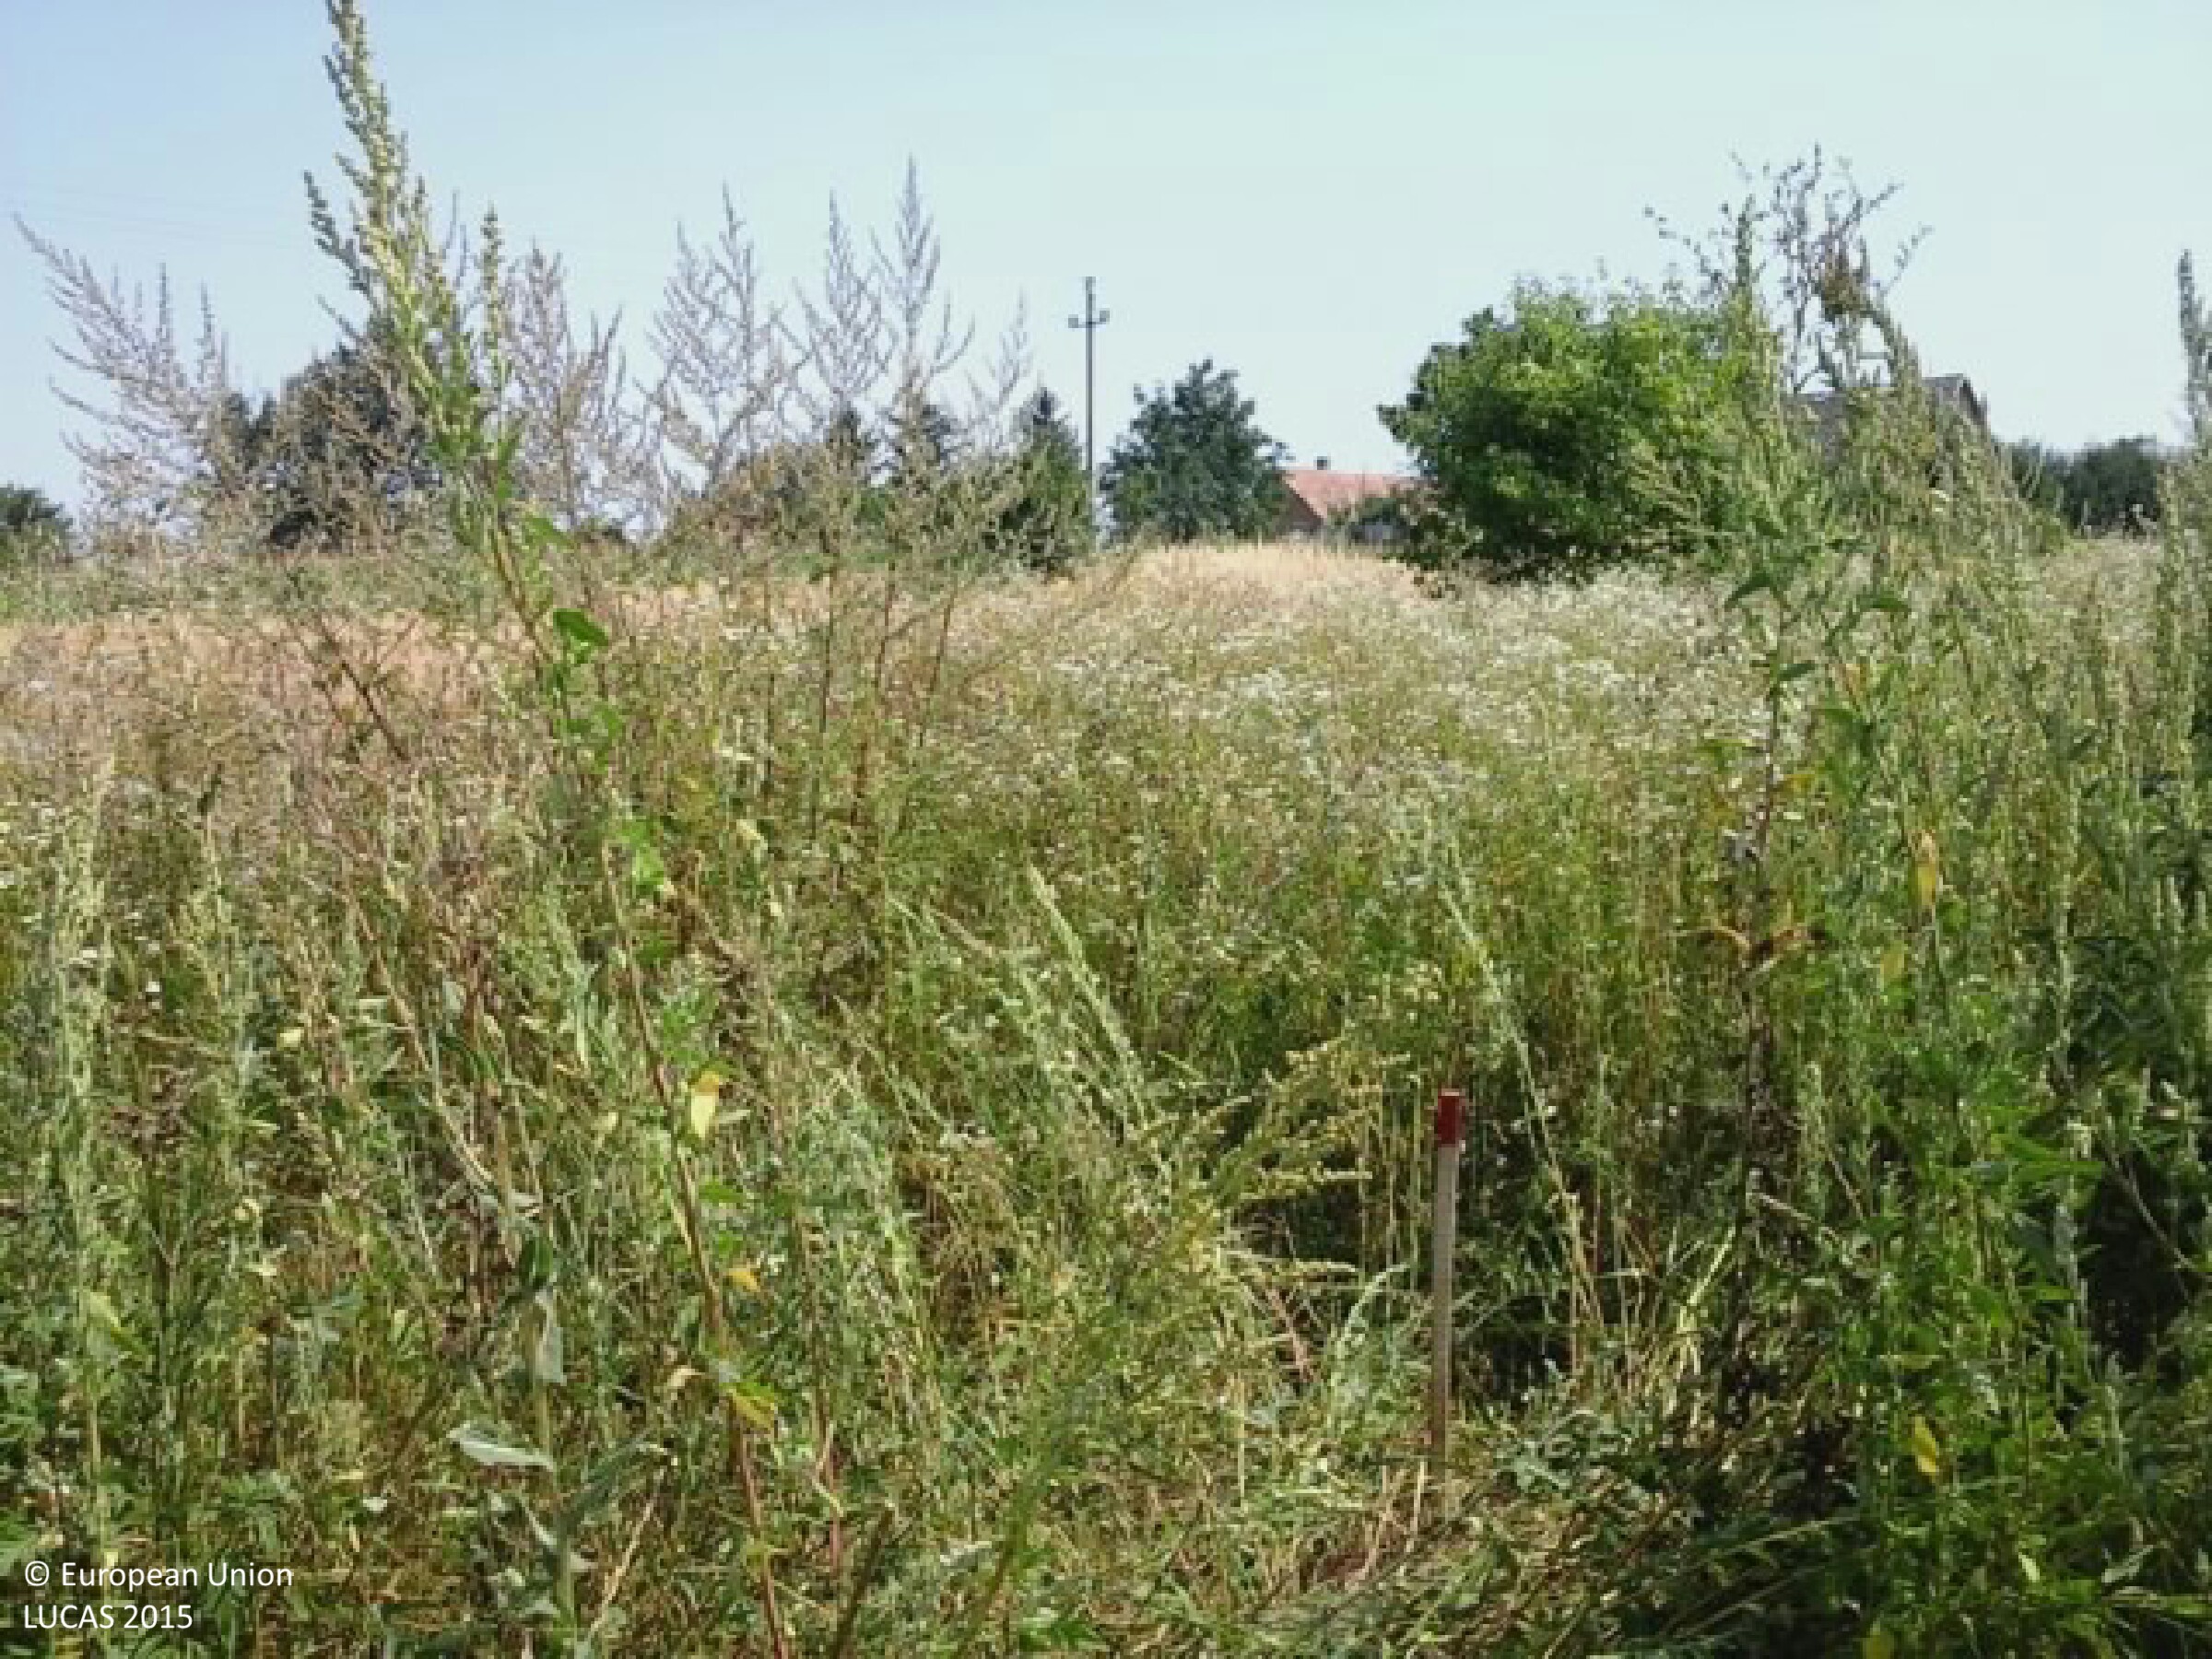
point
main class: Grassland
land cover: Spontaneously vegetated surfaces
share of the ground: > 75 %
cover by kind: herbaceous plants 100 %
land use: Residential
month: August
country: HU
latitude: 46.5889
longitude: 17.8247
